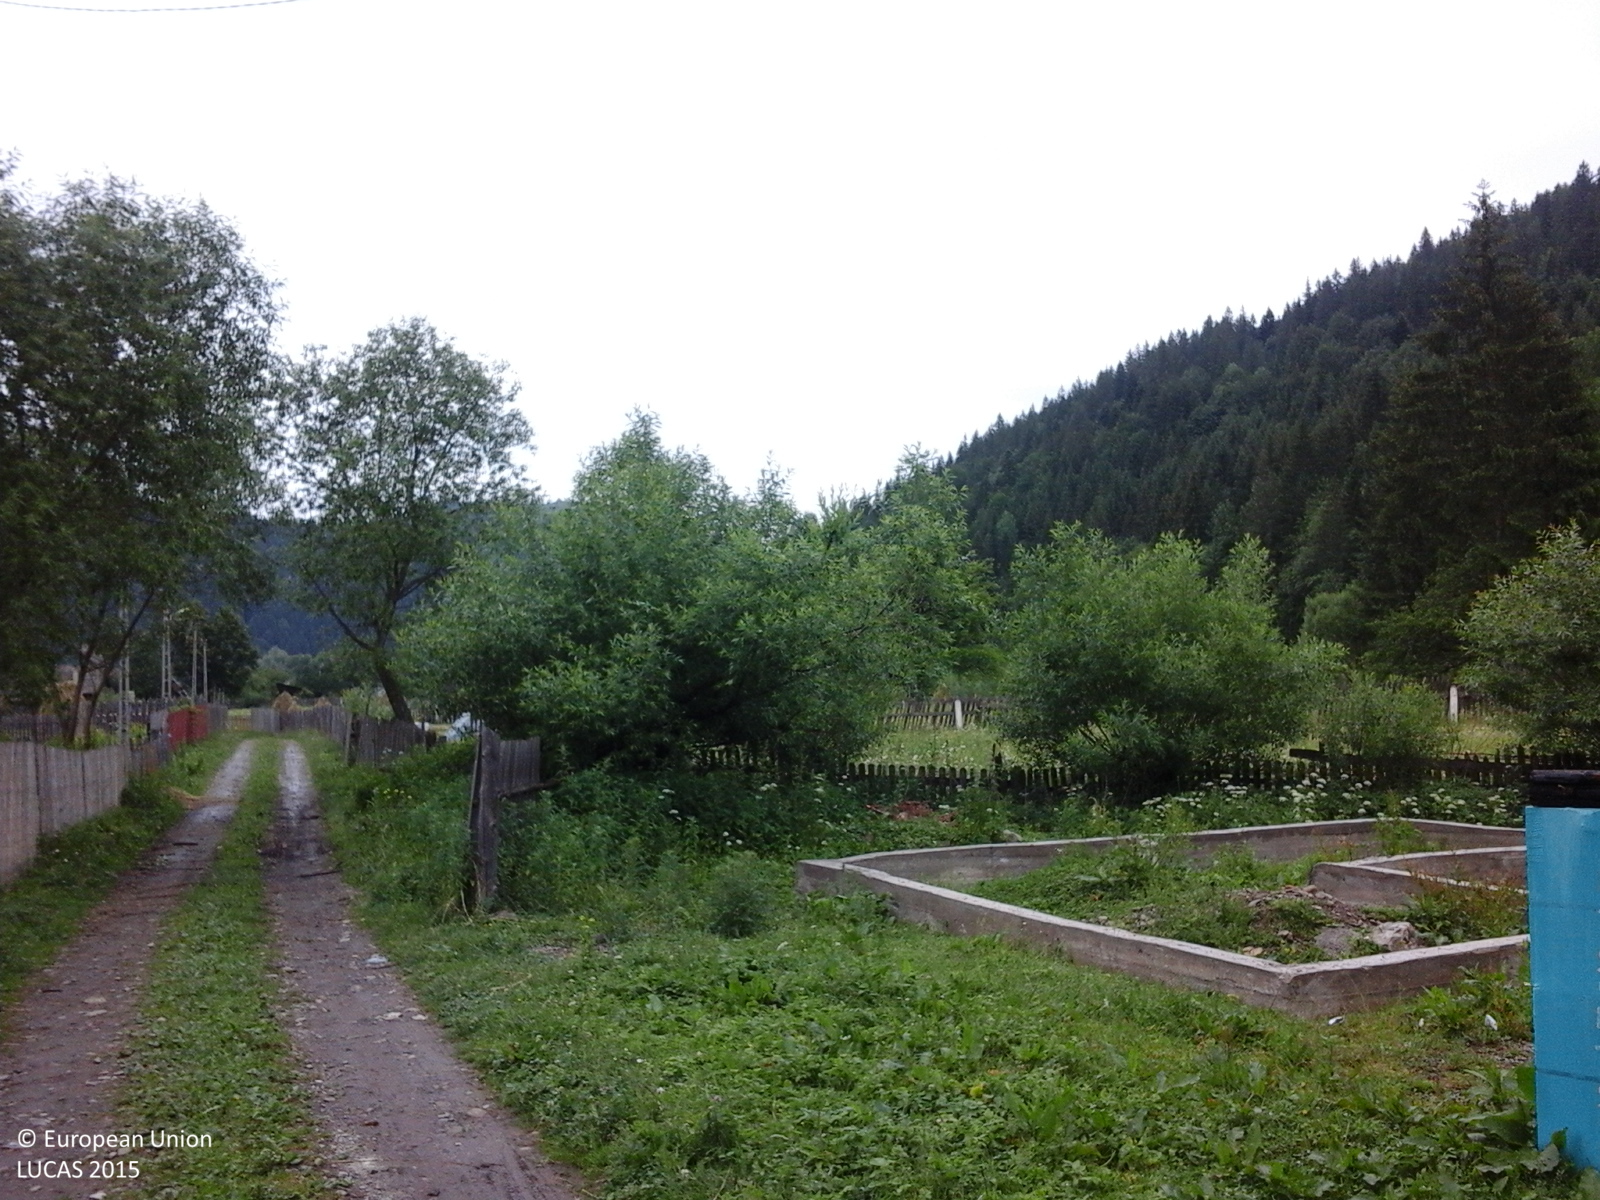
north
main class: Grassland
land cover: Grassland without tree/shrub cover
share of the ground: > 75 %
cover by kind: herbaceous plants 100 %
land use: Agriculture (excluding fallow land and kitchen gardens)
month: June
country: RO
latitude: 47.8800
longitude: 25.4275
